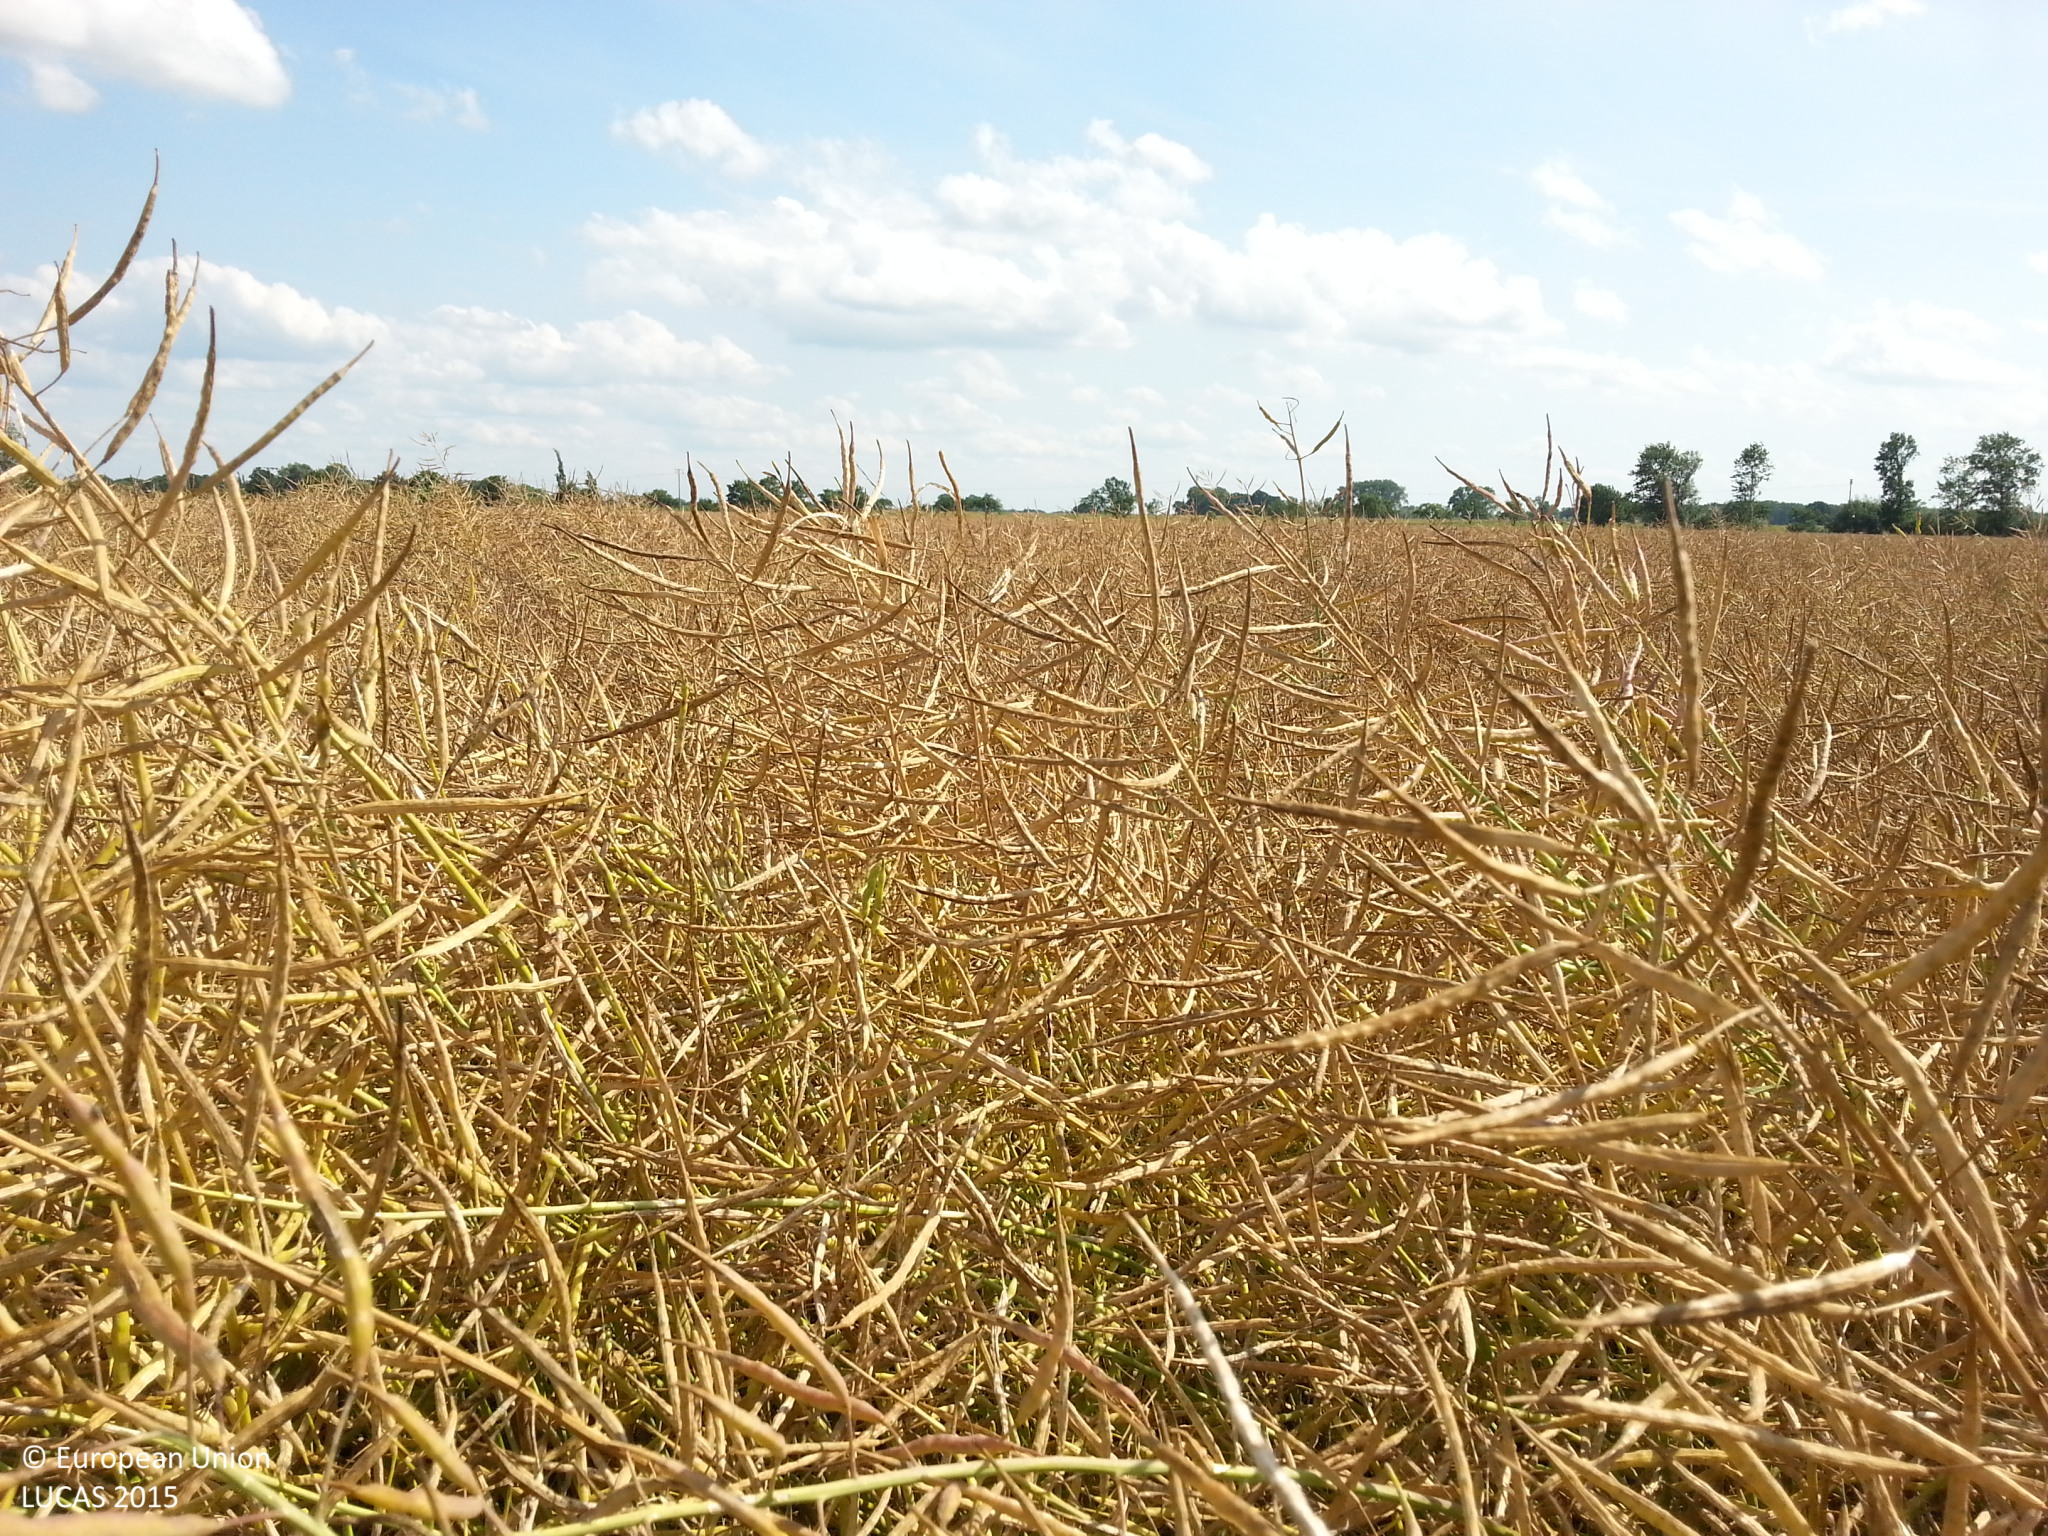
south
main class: Cropland
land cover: Rape and turnip rape
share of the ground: > 75 %
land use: Agriculture (excluding fallow land and kitchen gardens)
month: July
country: DE
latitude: 53.1808
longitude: 11.1517
